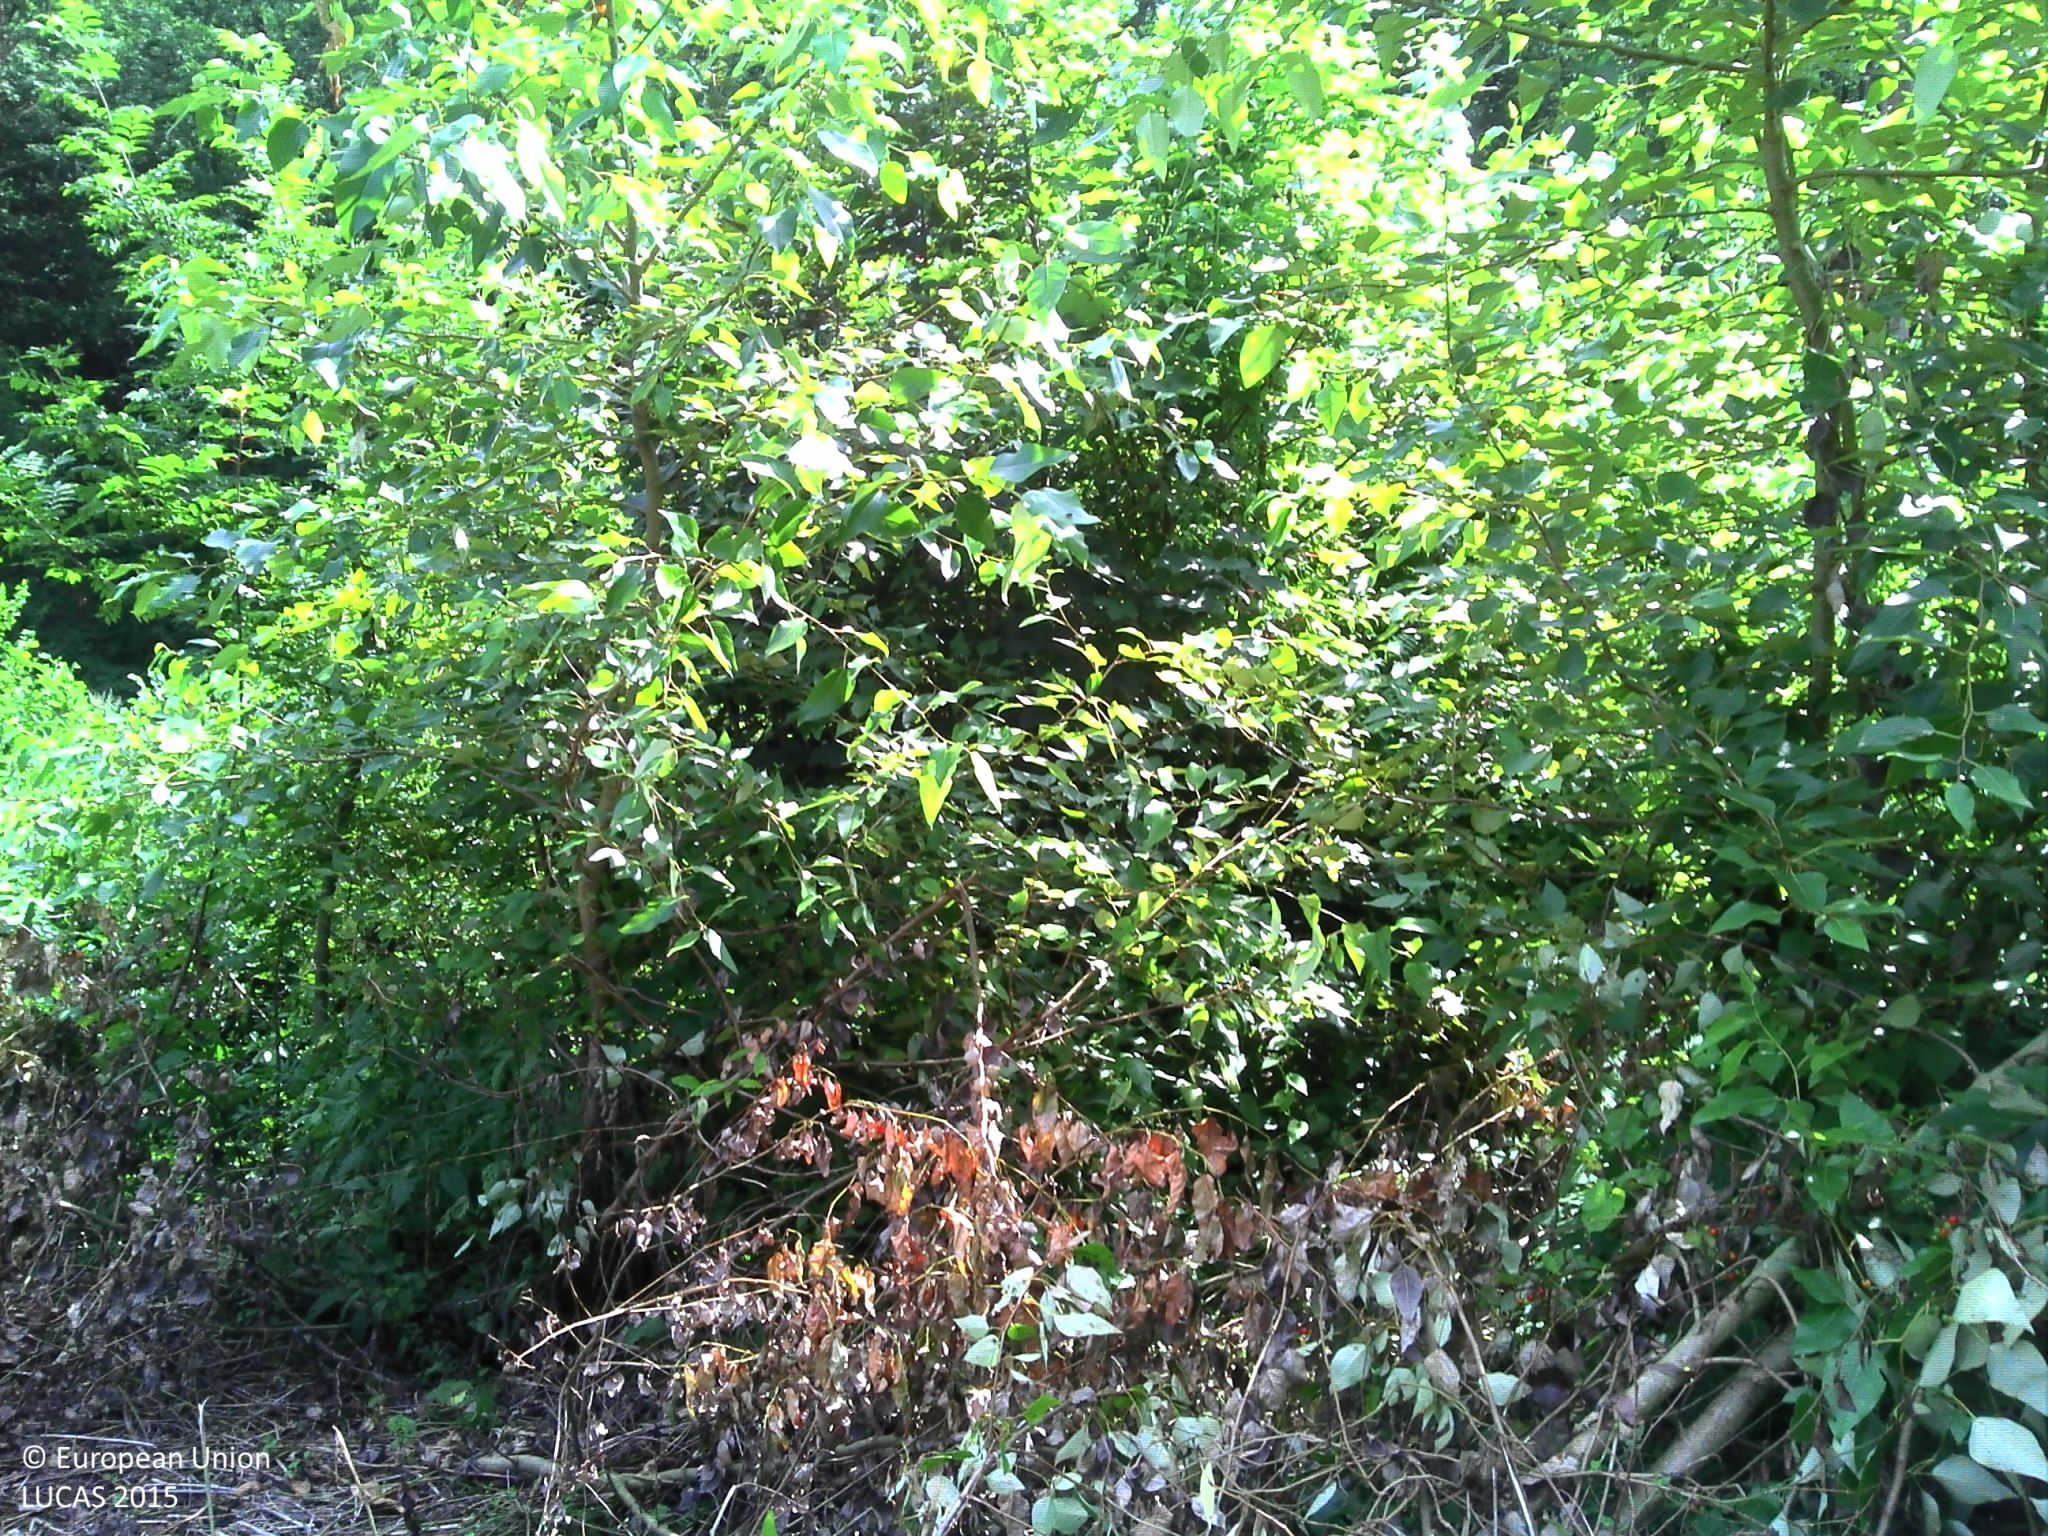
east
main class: Shrubland
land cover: Shrubland with sparse tree cover
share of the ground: > 75 %
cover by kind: shrubs 50 %, herbaceous plants 45 %, broadleaved forest trees 5 %
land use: Semi-natural and natural areas not in use
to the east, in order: Shrubland with sparse tree cover; Broadleaved woodland; Rivers and streams; Broadleaved woodland
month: August
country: BE
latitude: 50.3620
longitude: 4.5841
